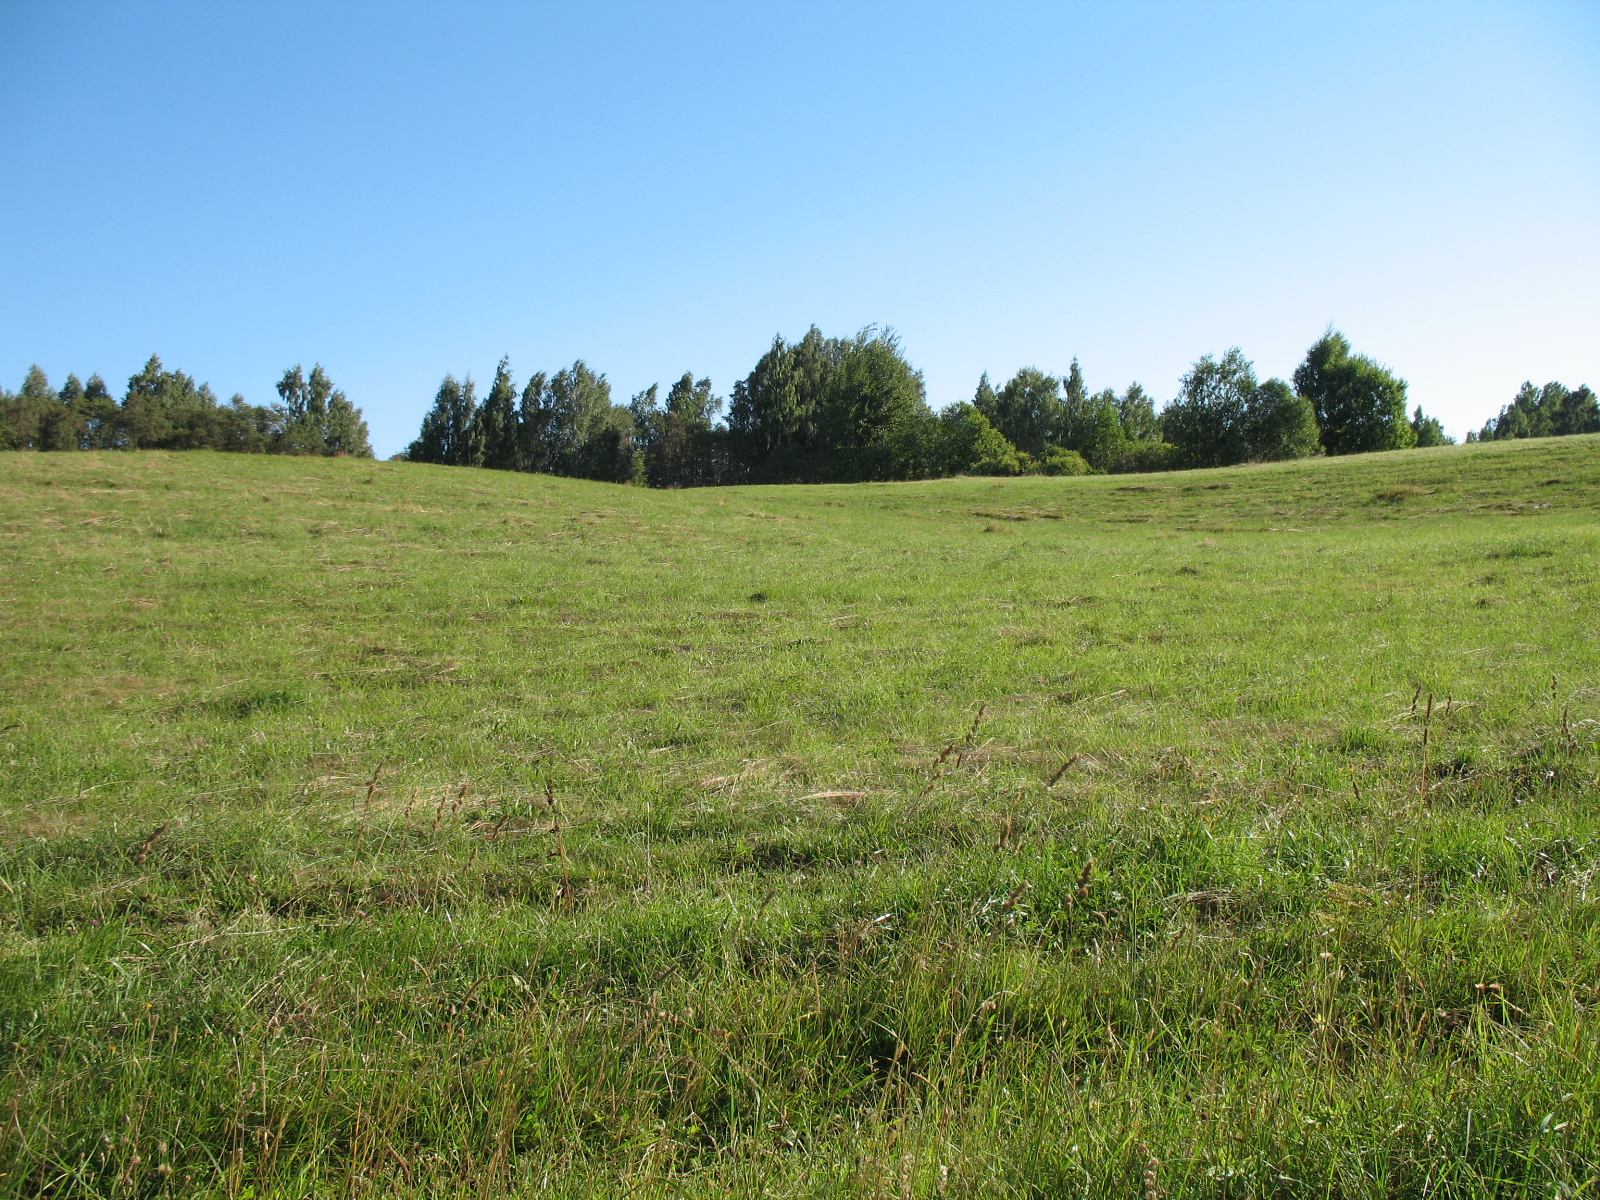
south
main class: Grassland
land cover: Grassland without tree/shrub cover
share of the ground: > 75 %
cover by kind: herbaceous plants 100 %
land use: Agriculture (excluding fallow land and kitchen gardens)
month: August
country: LV
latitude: 56.4915
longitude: 25.6012
